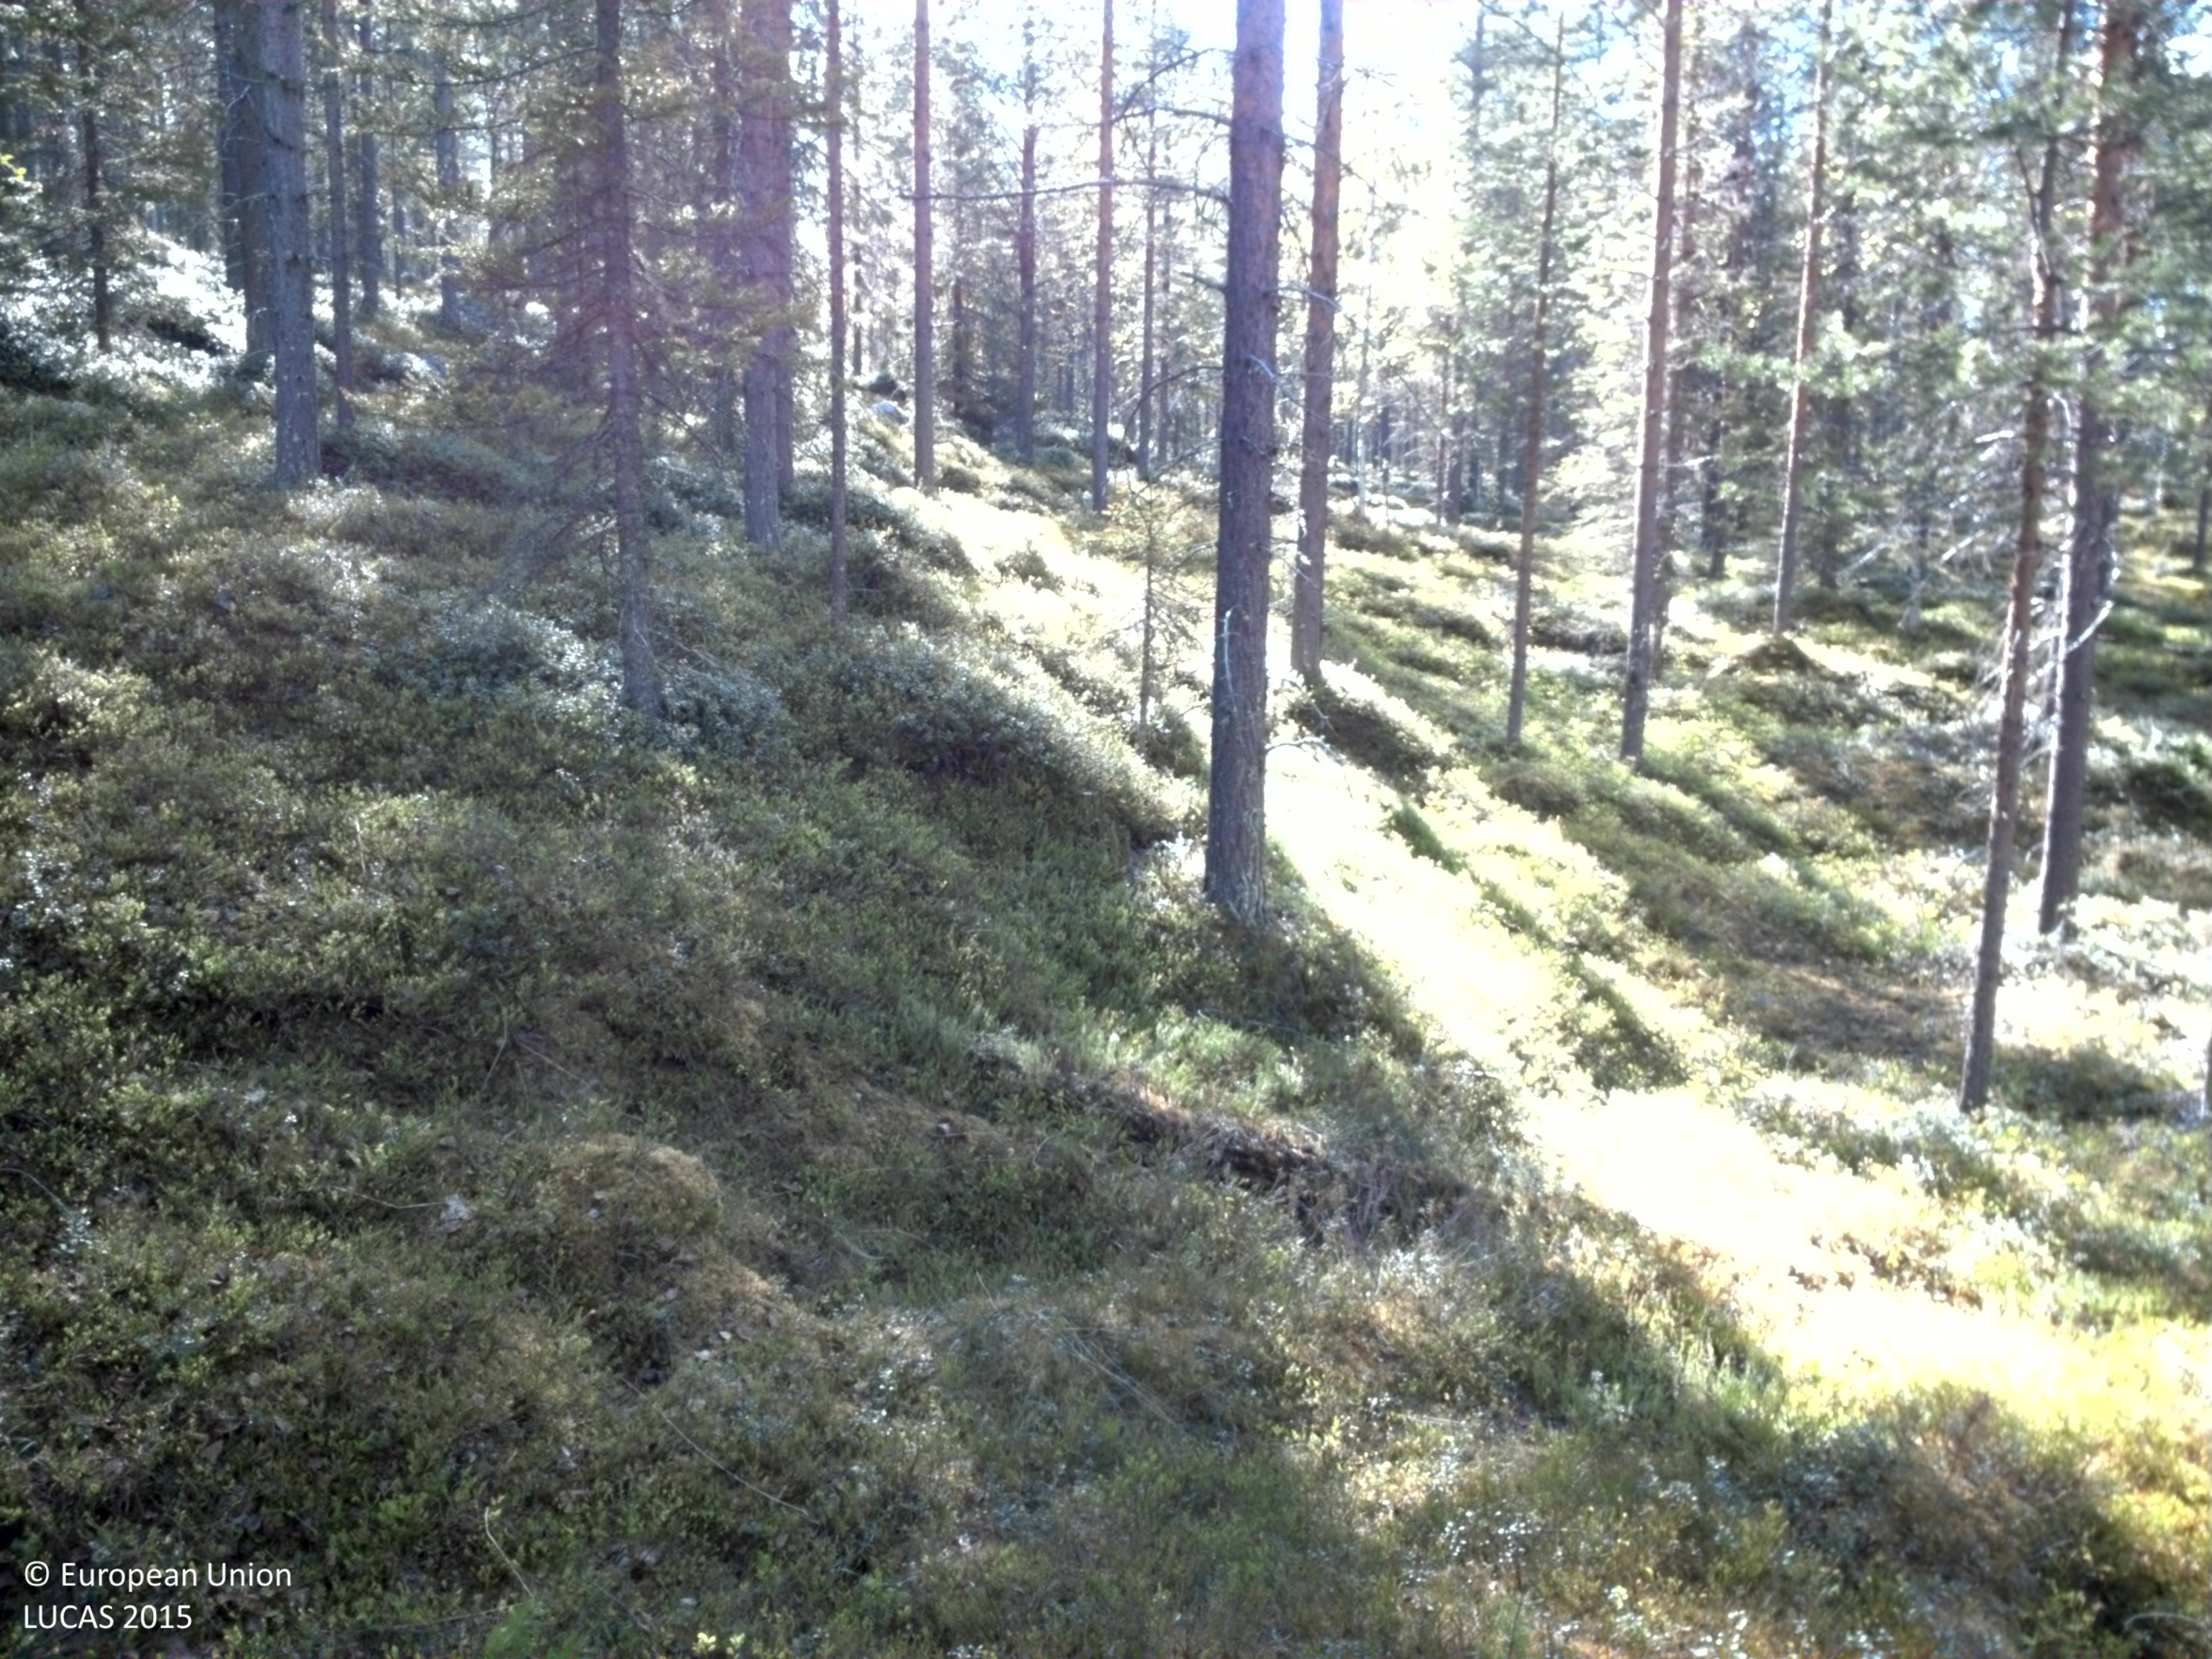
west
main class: Woodland
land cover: Pine dominated coniferous woodland
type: boreal forest
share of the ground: 25 - 50 %
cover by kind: herbaceous plants 65 %, coniferous forest trees 35 %
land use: Forestry
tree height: > 5 m
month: June
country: SE
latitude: 66.9420
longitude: 21.2811
